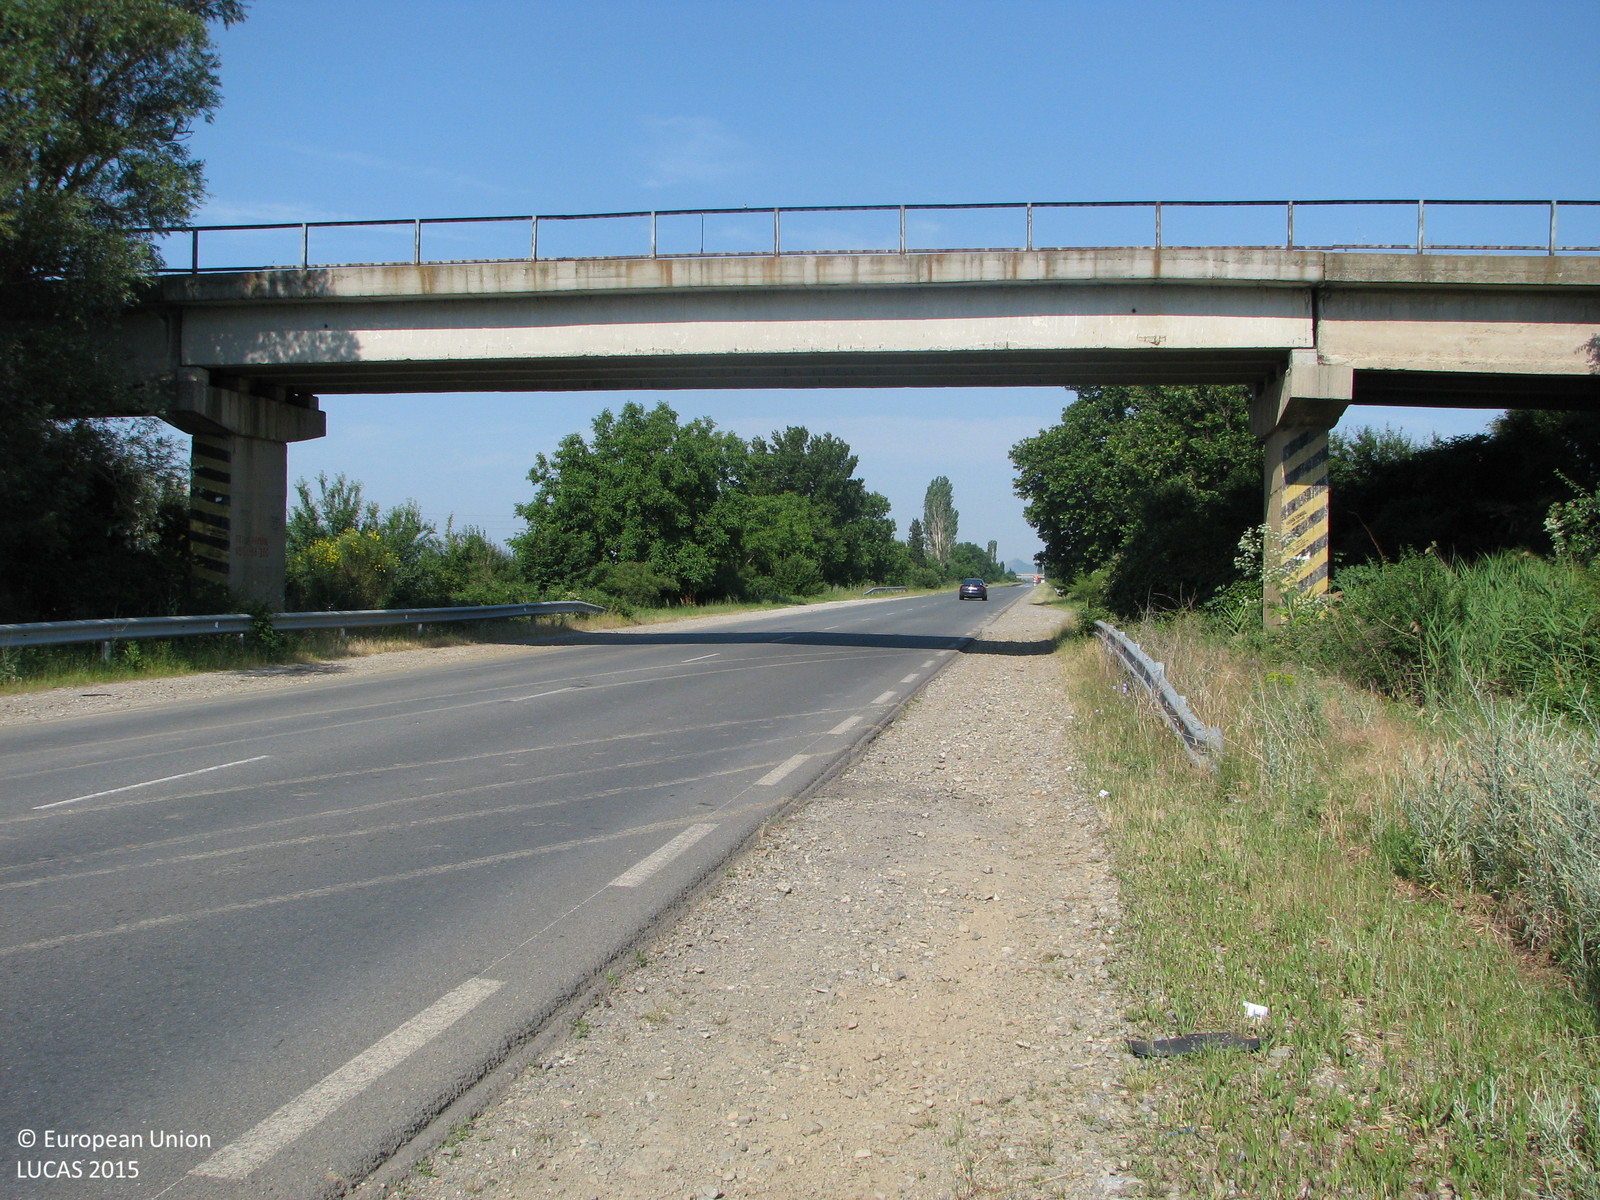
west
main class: Grassland
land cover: Grassland with sparse tree/shrub cover
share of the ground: > 75 %
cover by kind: herbaceous plants 90 %, coniferous forest trees 5 %, shrubs 5 %
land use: Abandoned areas
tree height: < 5 m
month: June
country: BG
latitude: 42.6372
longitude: 26.2468
